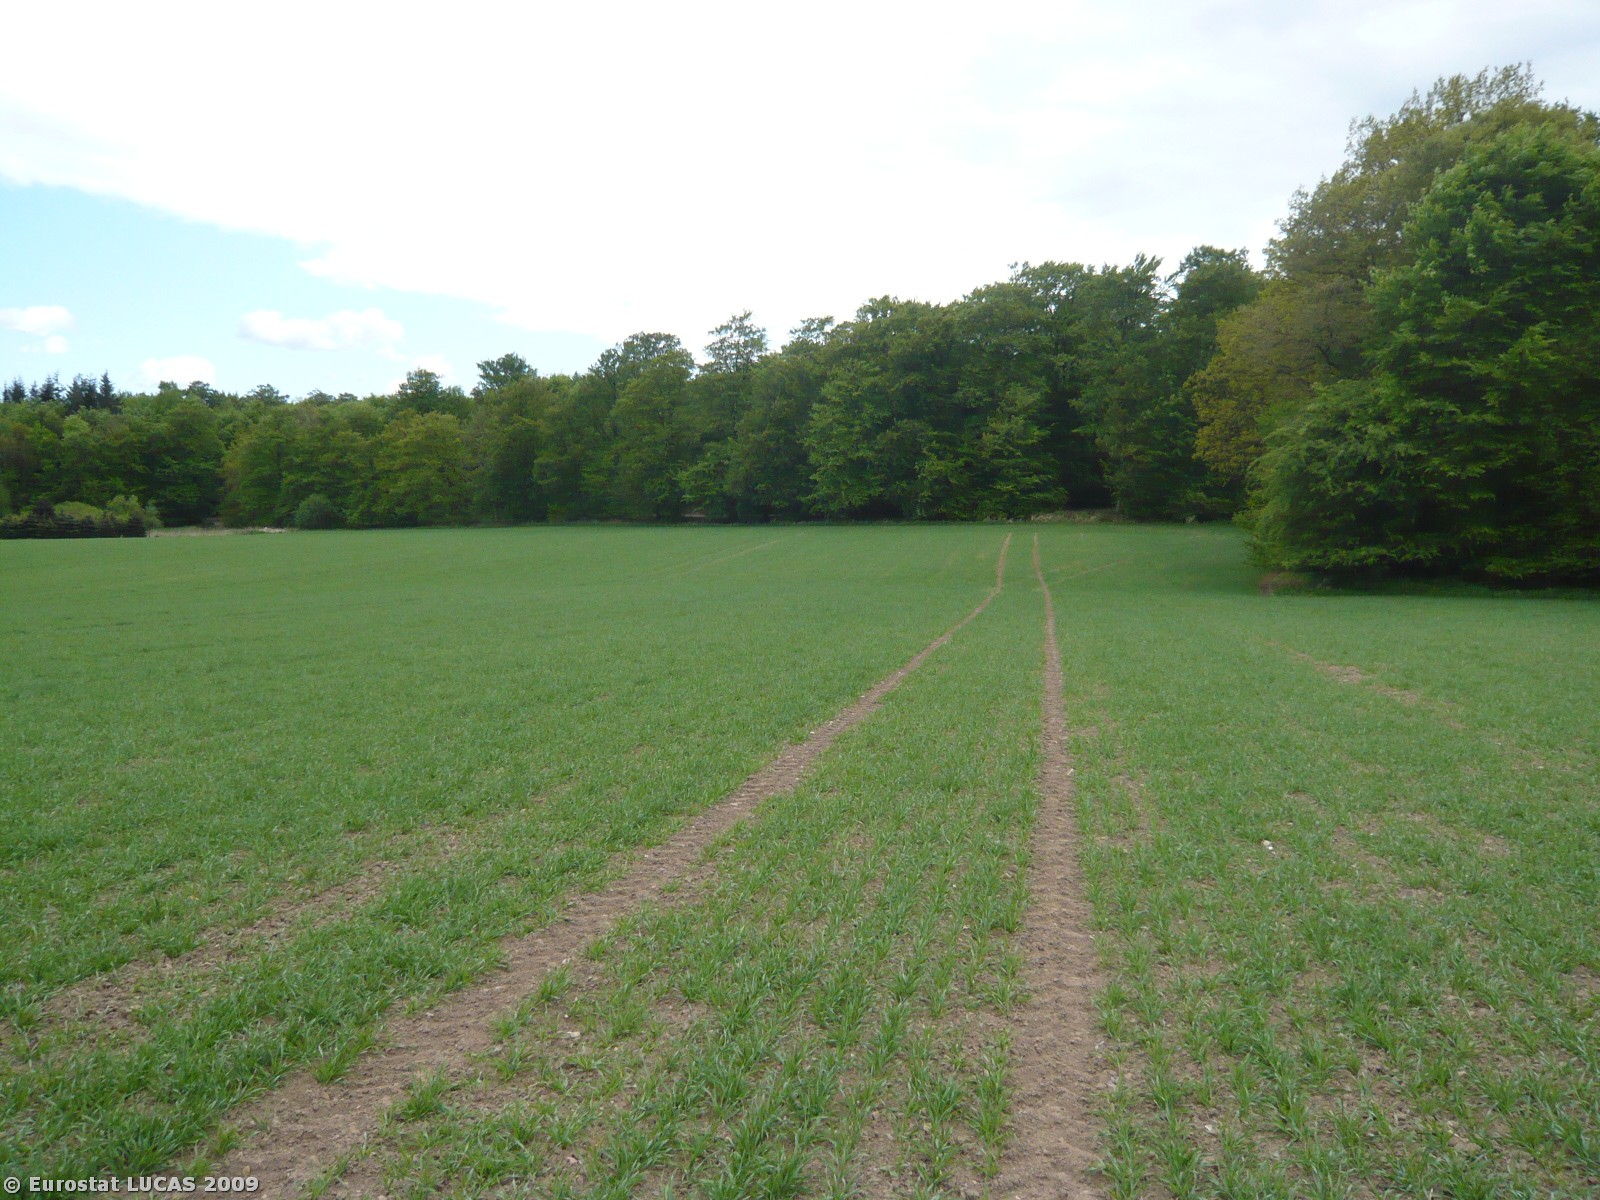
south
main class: Cropland
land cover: Common wheat
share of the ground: 25 - 50 %
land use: Agriculture (excluding fallow land and kitchen gardens)
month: May
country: DK
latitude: 55.0940
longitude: 11.9573
